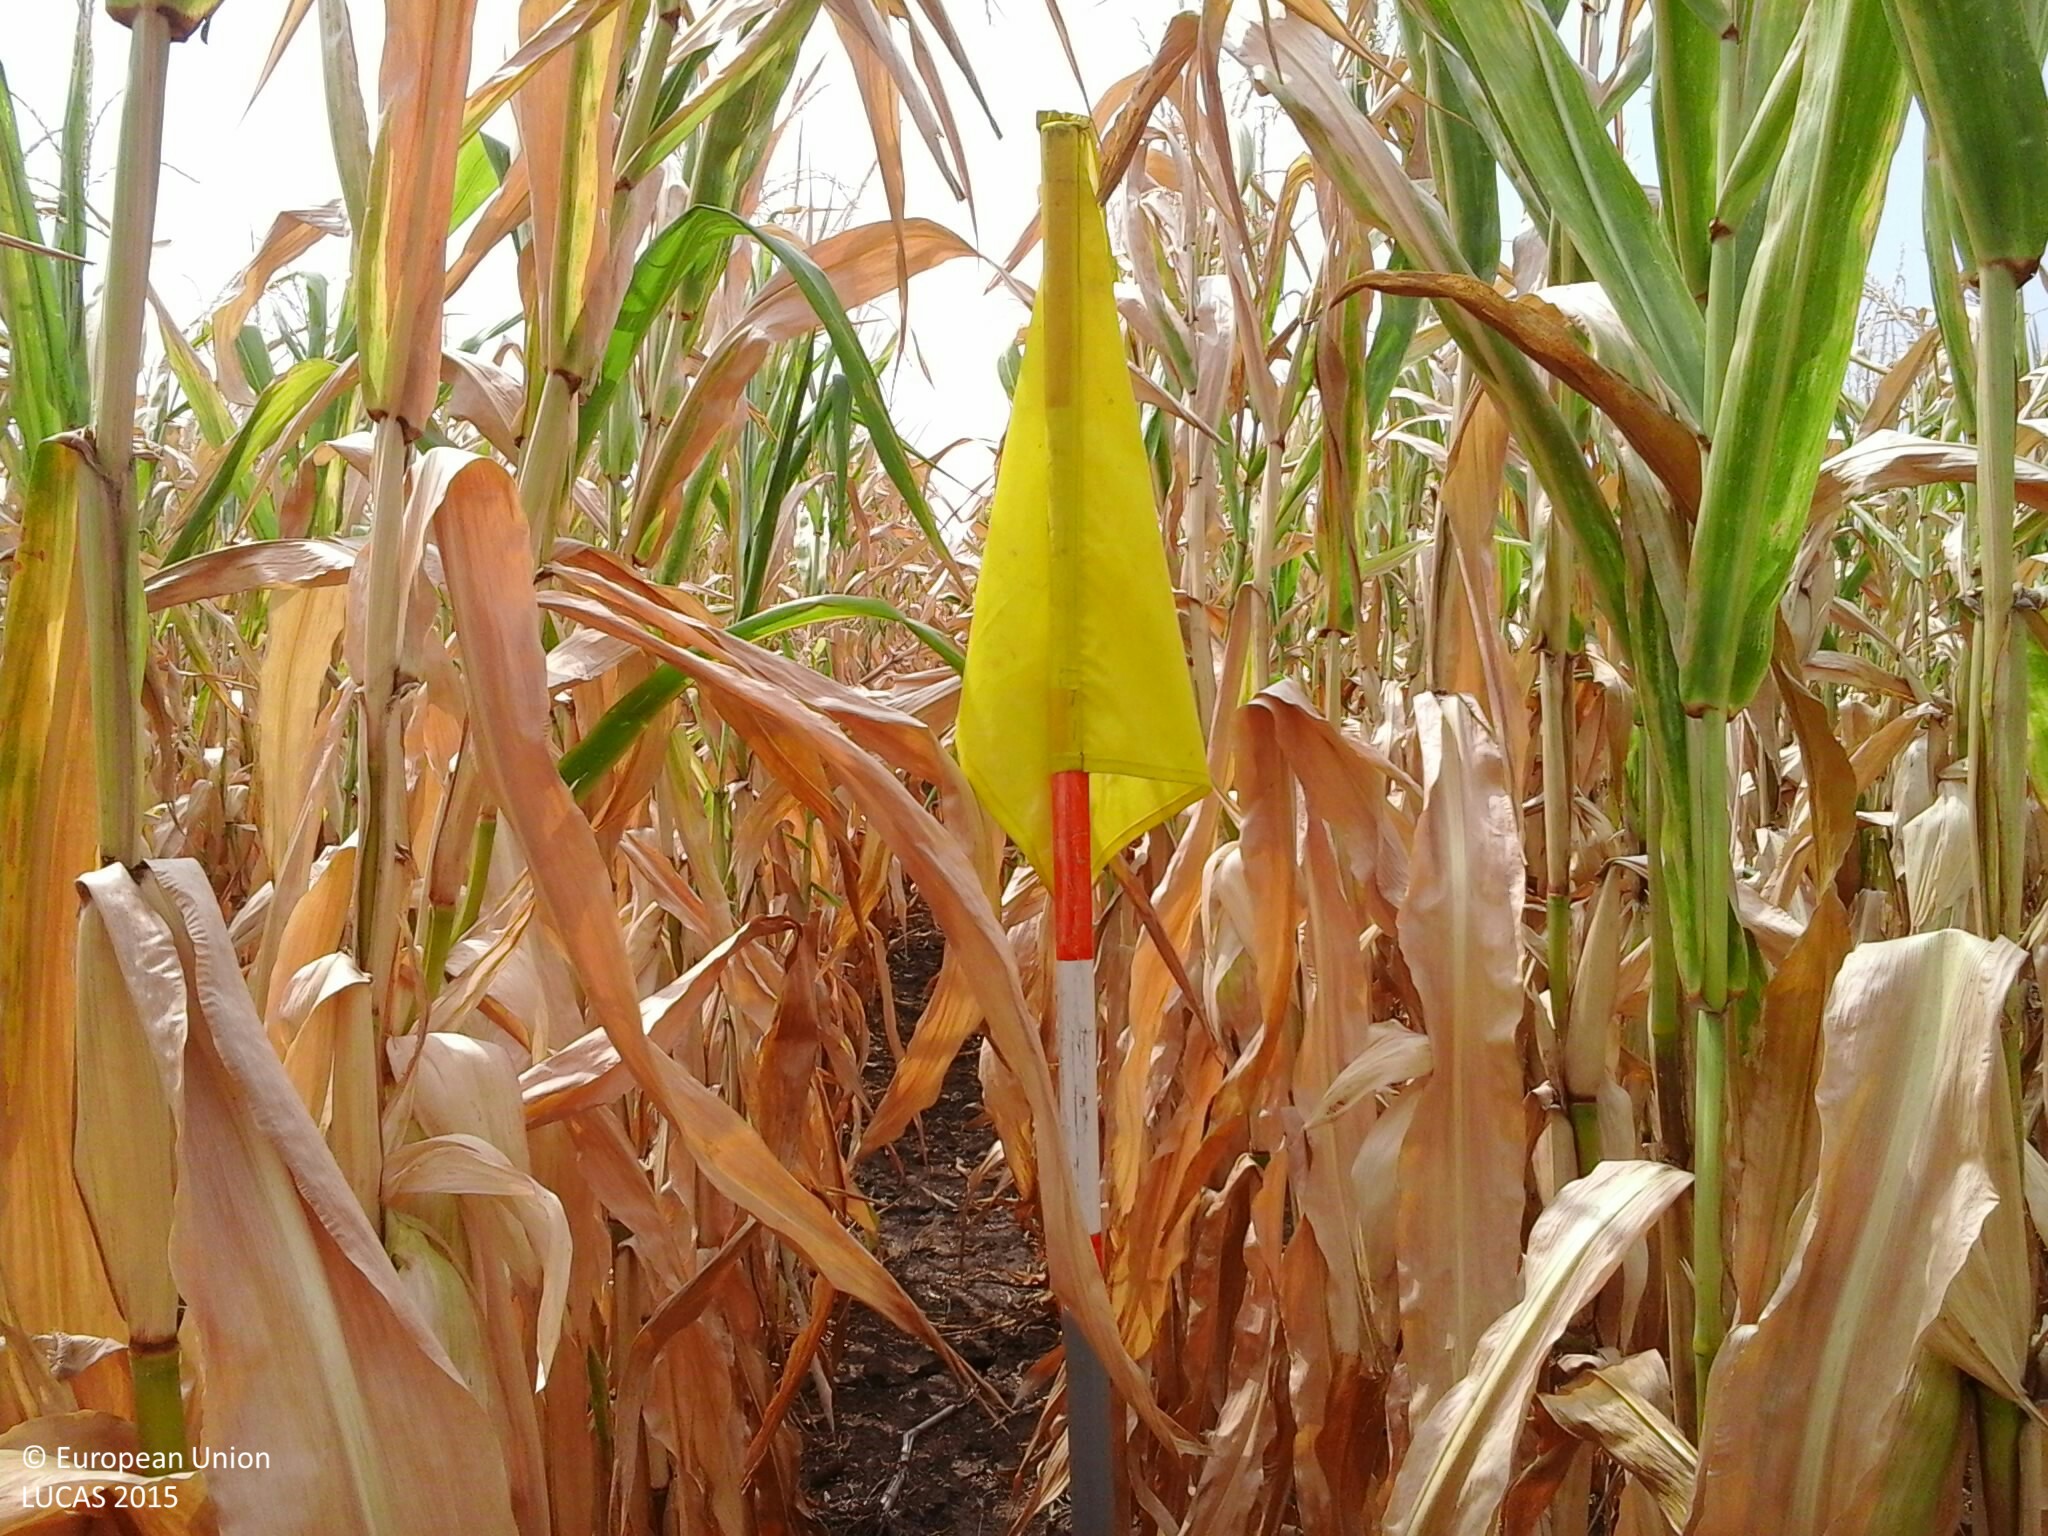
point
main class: Cropland
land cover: Maize
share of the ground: > 75 %
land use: Agriculture (excluding fallow land and kitchen gardens)
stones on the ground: < 10 %
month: August
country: HU
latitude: 47.7590
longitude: 20.2889
